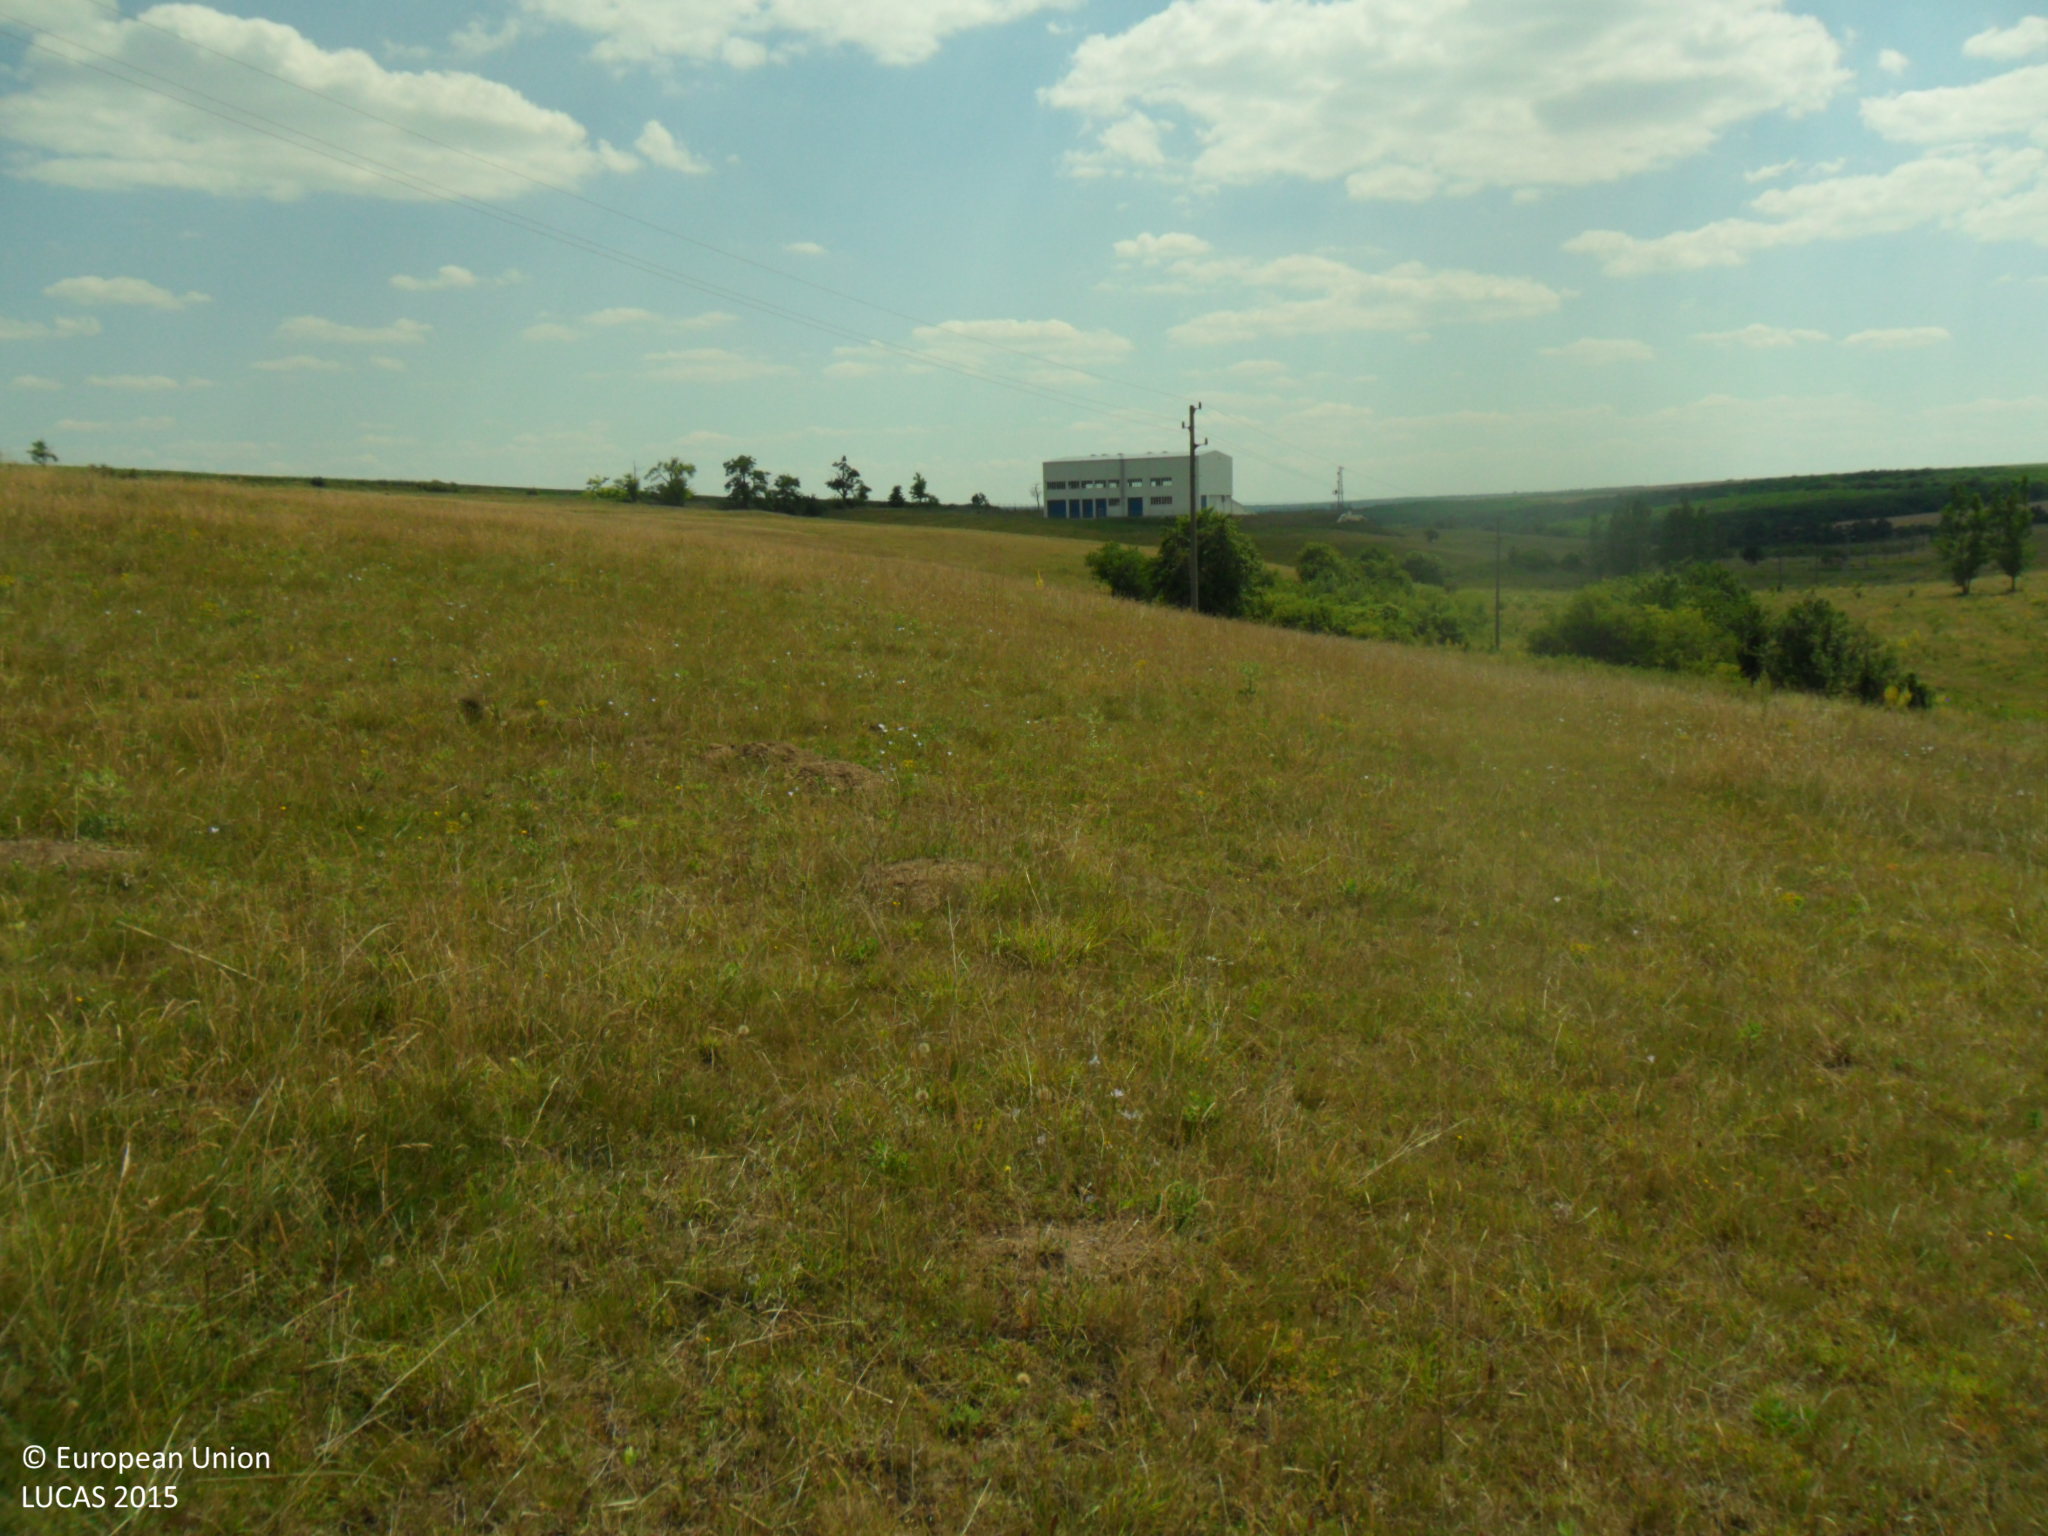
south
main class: Grassland
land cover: Grassland without tree/shrub cover
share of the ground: > 75 %
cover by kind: herbaceous plants 100 %
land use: Agriculture (excluding fallow land and kitchen gardens)
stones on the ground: < 10 %
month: June
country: BG
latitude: 43.4611
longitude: 26.9366
